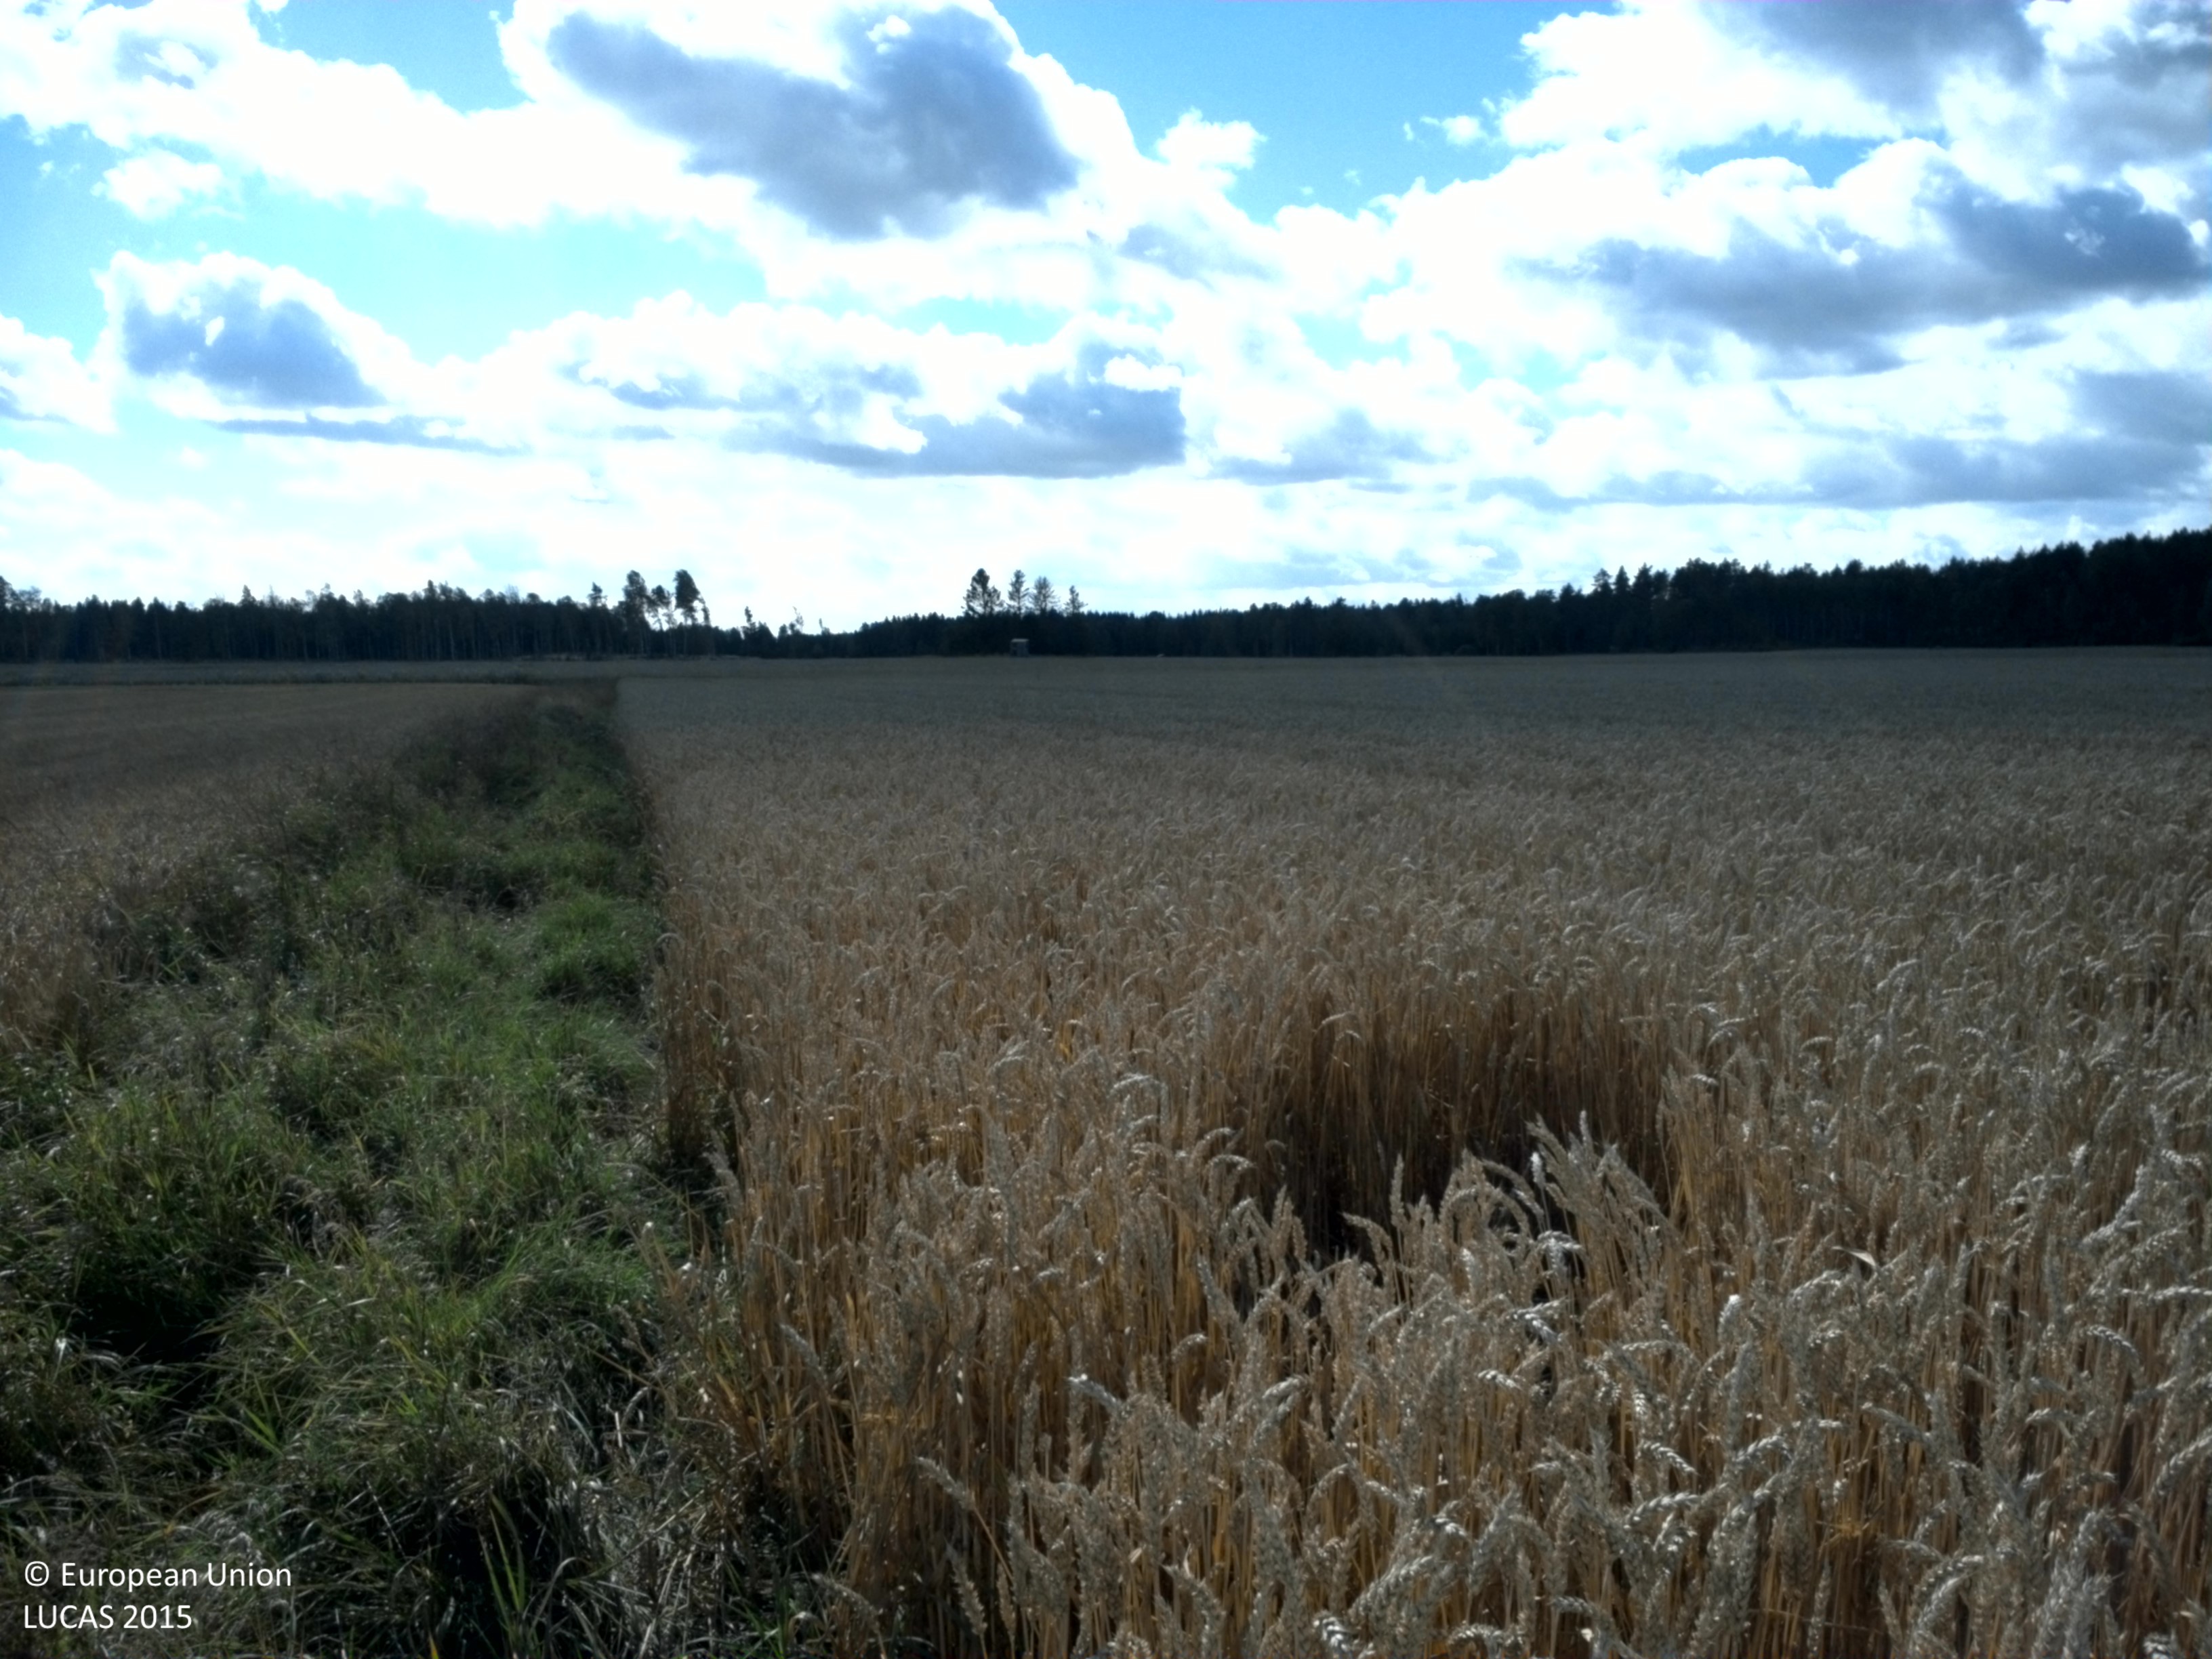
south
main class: Cropland
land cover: Common wheat
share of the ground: > 75 %
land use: Agriculture (excluding fallow land and kitchen gardens)
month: August
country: SE
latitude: 59.7042
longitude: 16.9059
